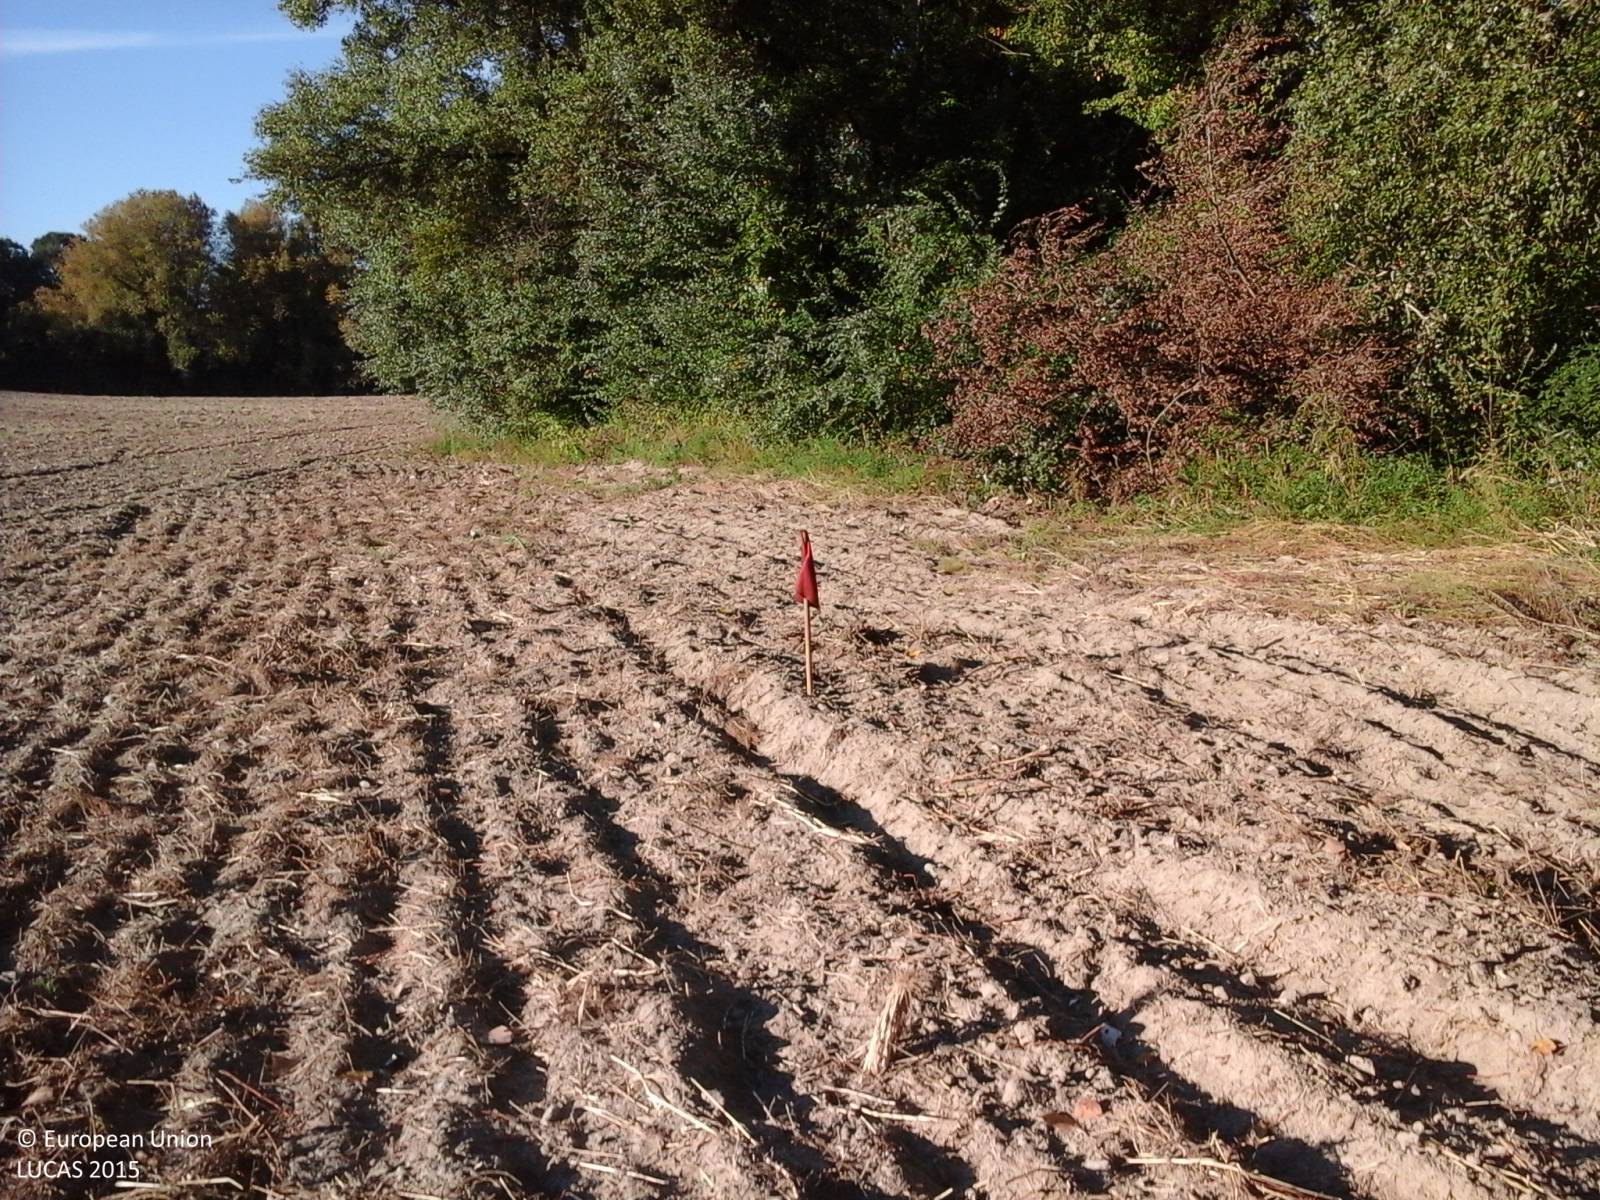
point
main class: Cropland
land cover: Durum wheat
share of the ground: < 10 %
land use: Agriculture (excluding fallow land and kitchen gardens)
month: September
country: IT
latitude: 42.6116
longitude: 12.2236
